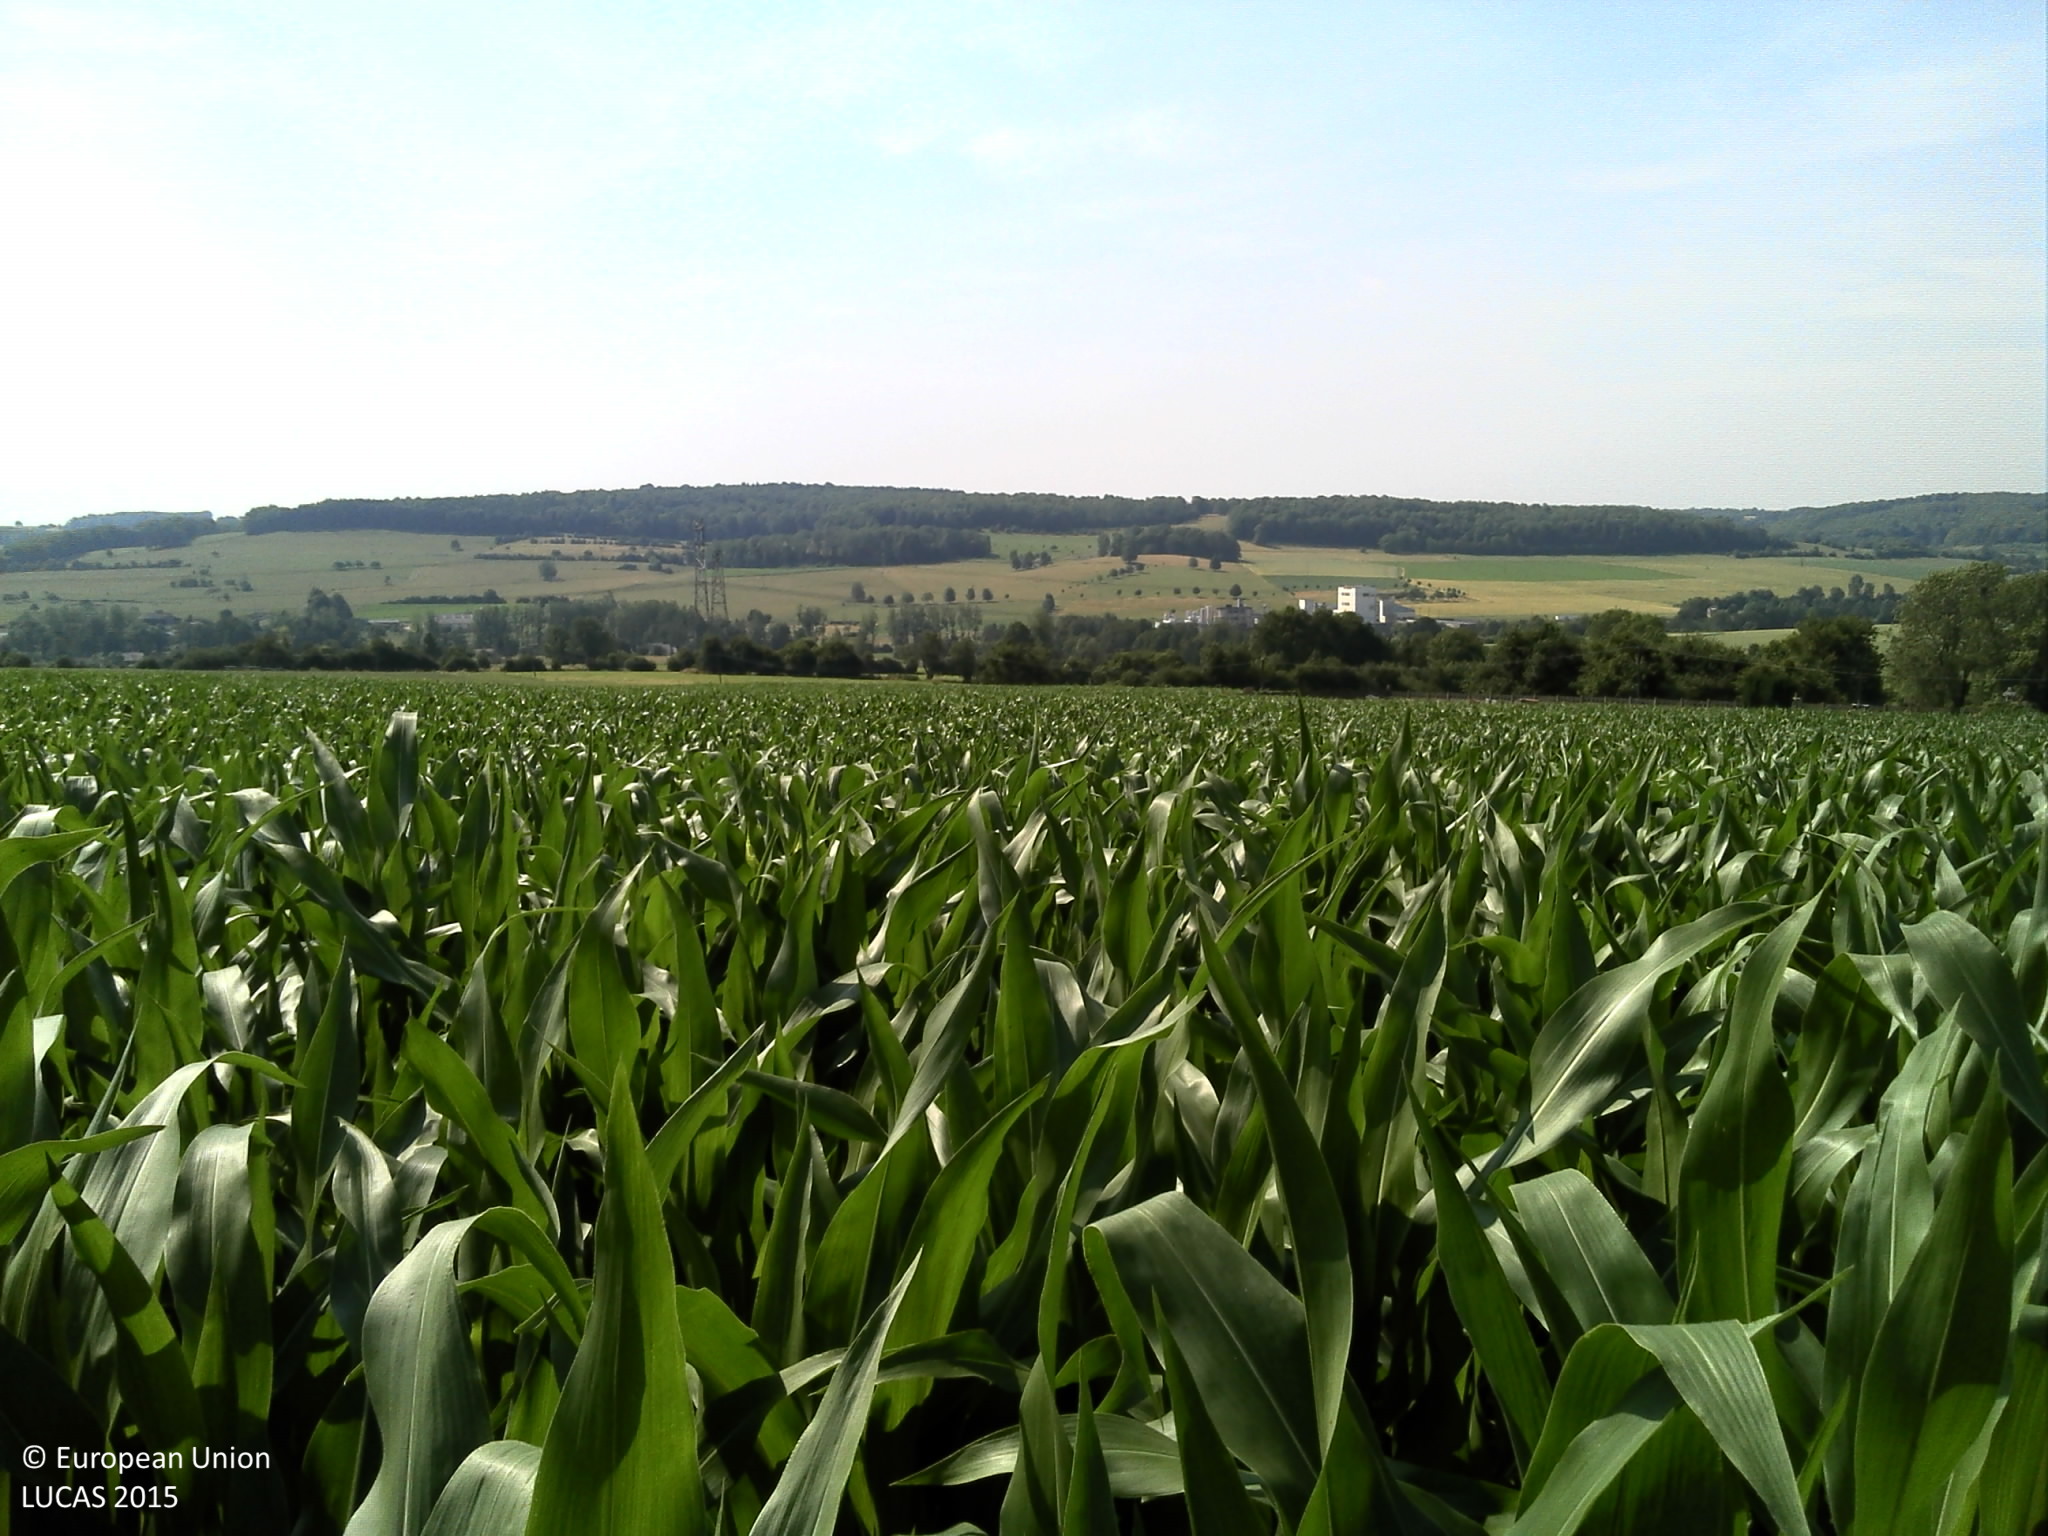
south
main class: Cropland
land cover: Maize
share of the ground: > 75 %
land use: Agriculture (excluding fallow land and kitchen gardens)
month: July
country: FR
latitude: 49.7982
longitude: 4.4806
